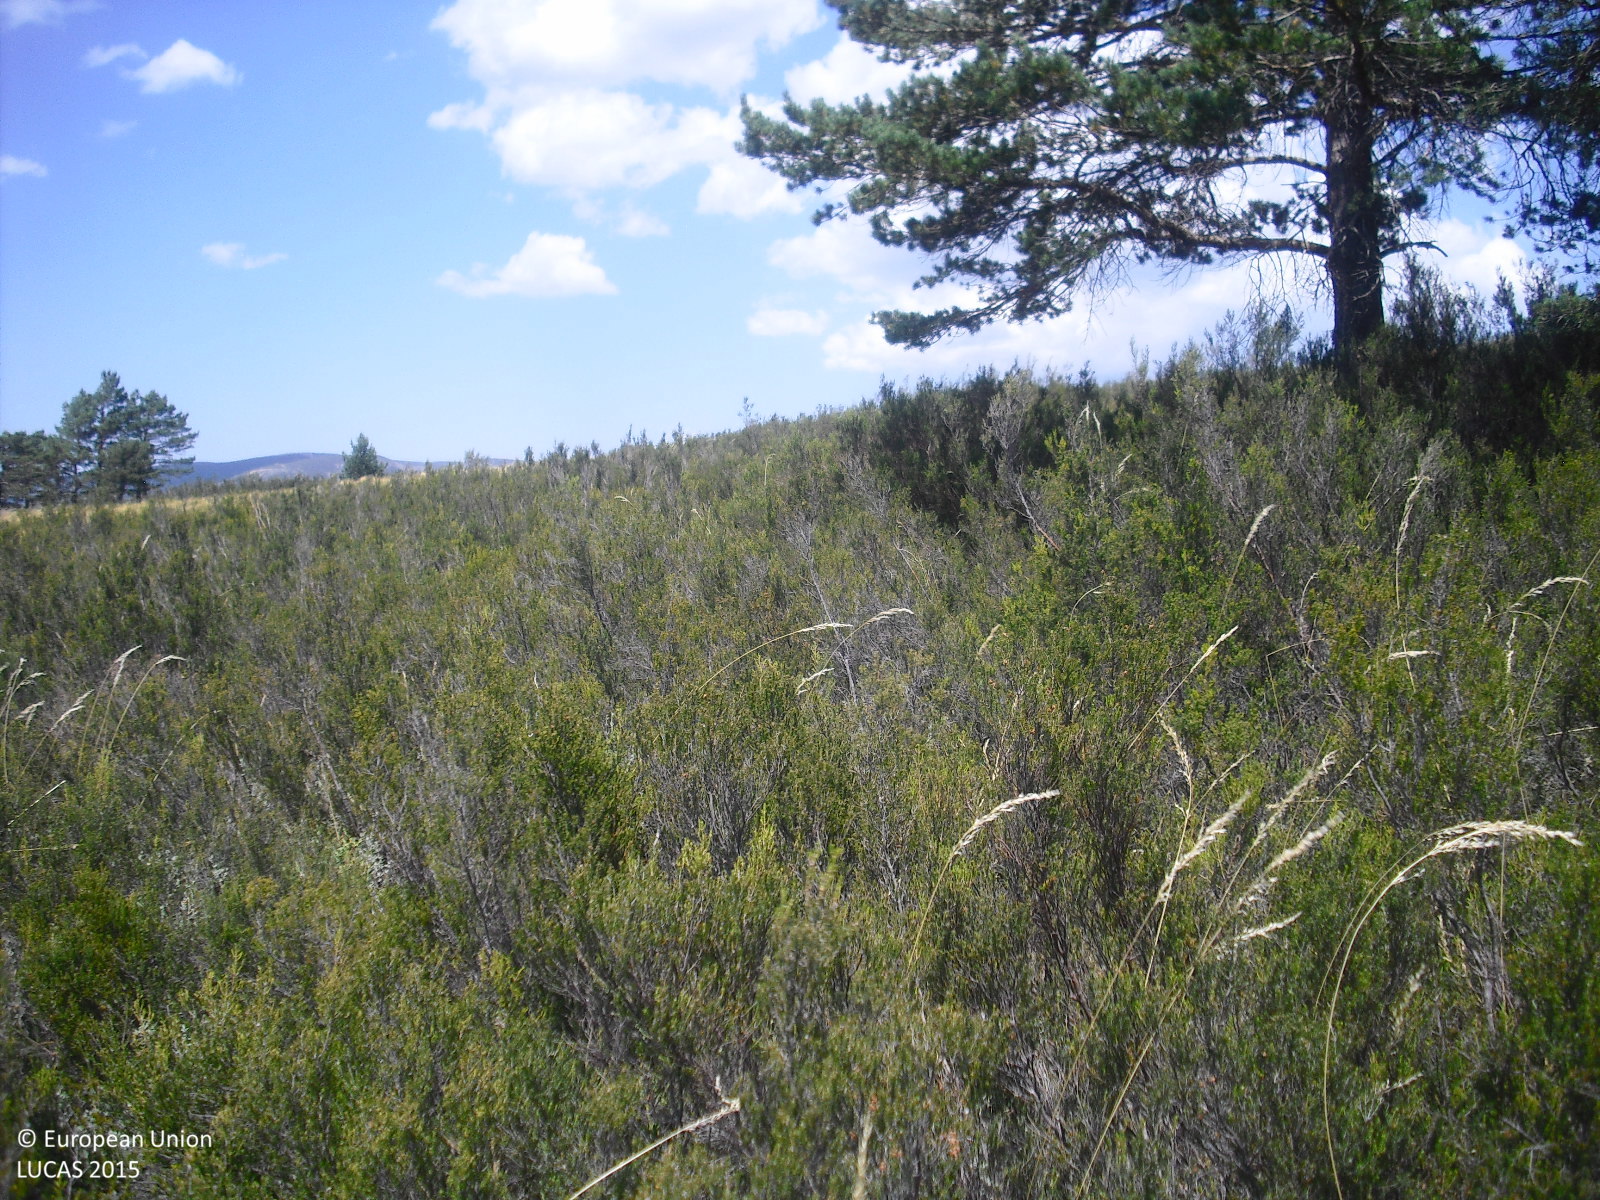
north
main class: Shrubland
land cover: Shrubland with sparse tree cover
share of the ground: > 75 %
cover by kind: shrubs 95 %, coniferous forest trees 5 %
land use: Semi-natural and natural areas not in use
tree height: < 5 m
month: August
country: ES
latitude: 42.1250
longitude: -7.3211
